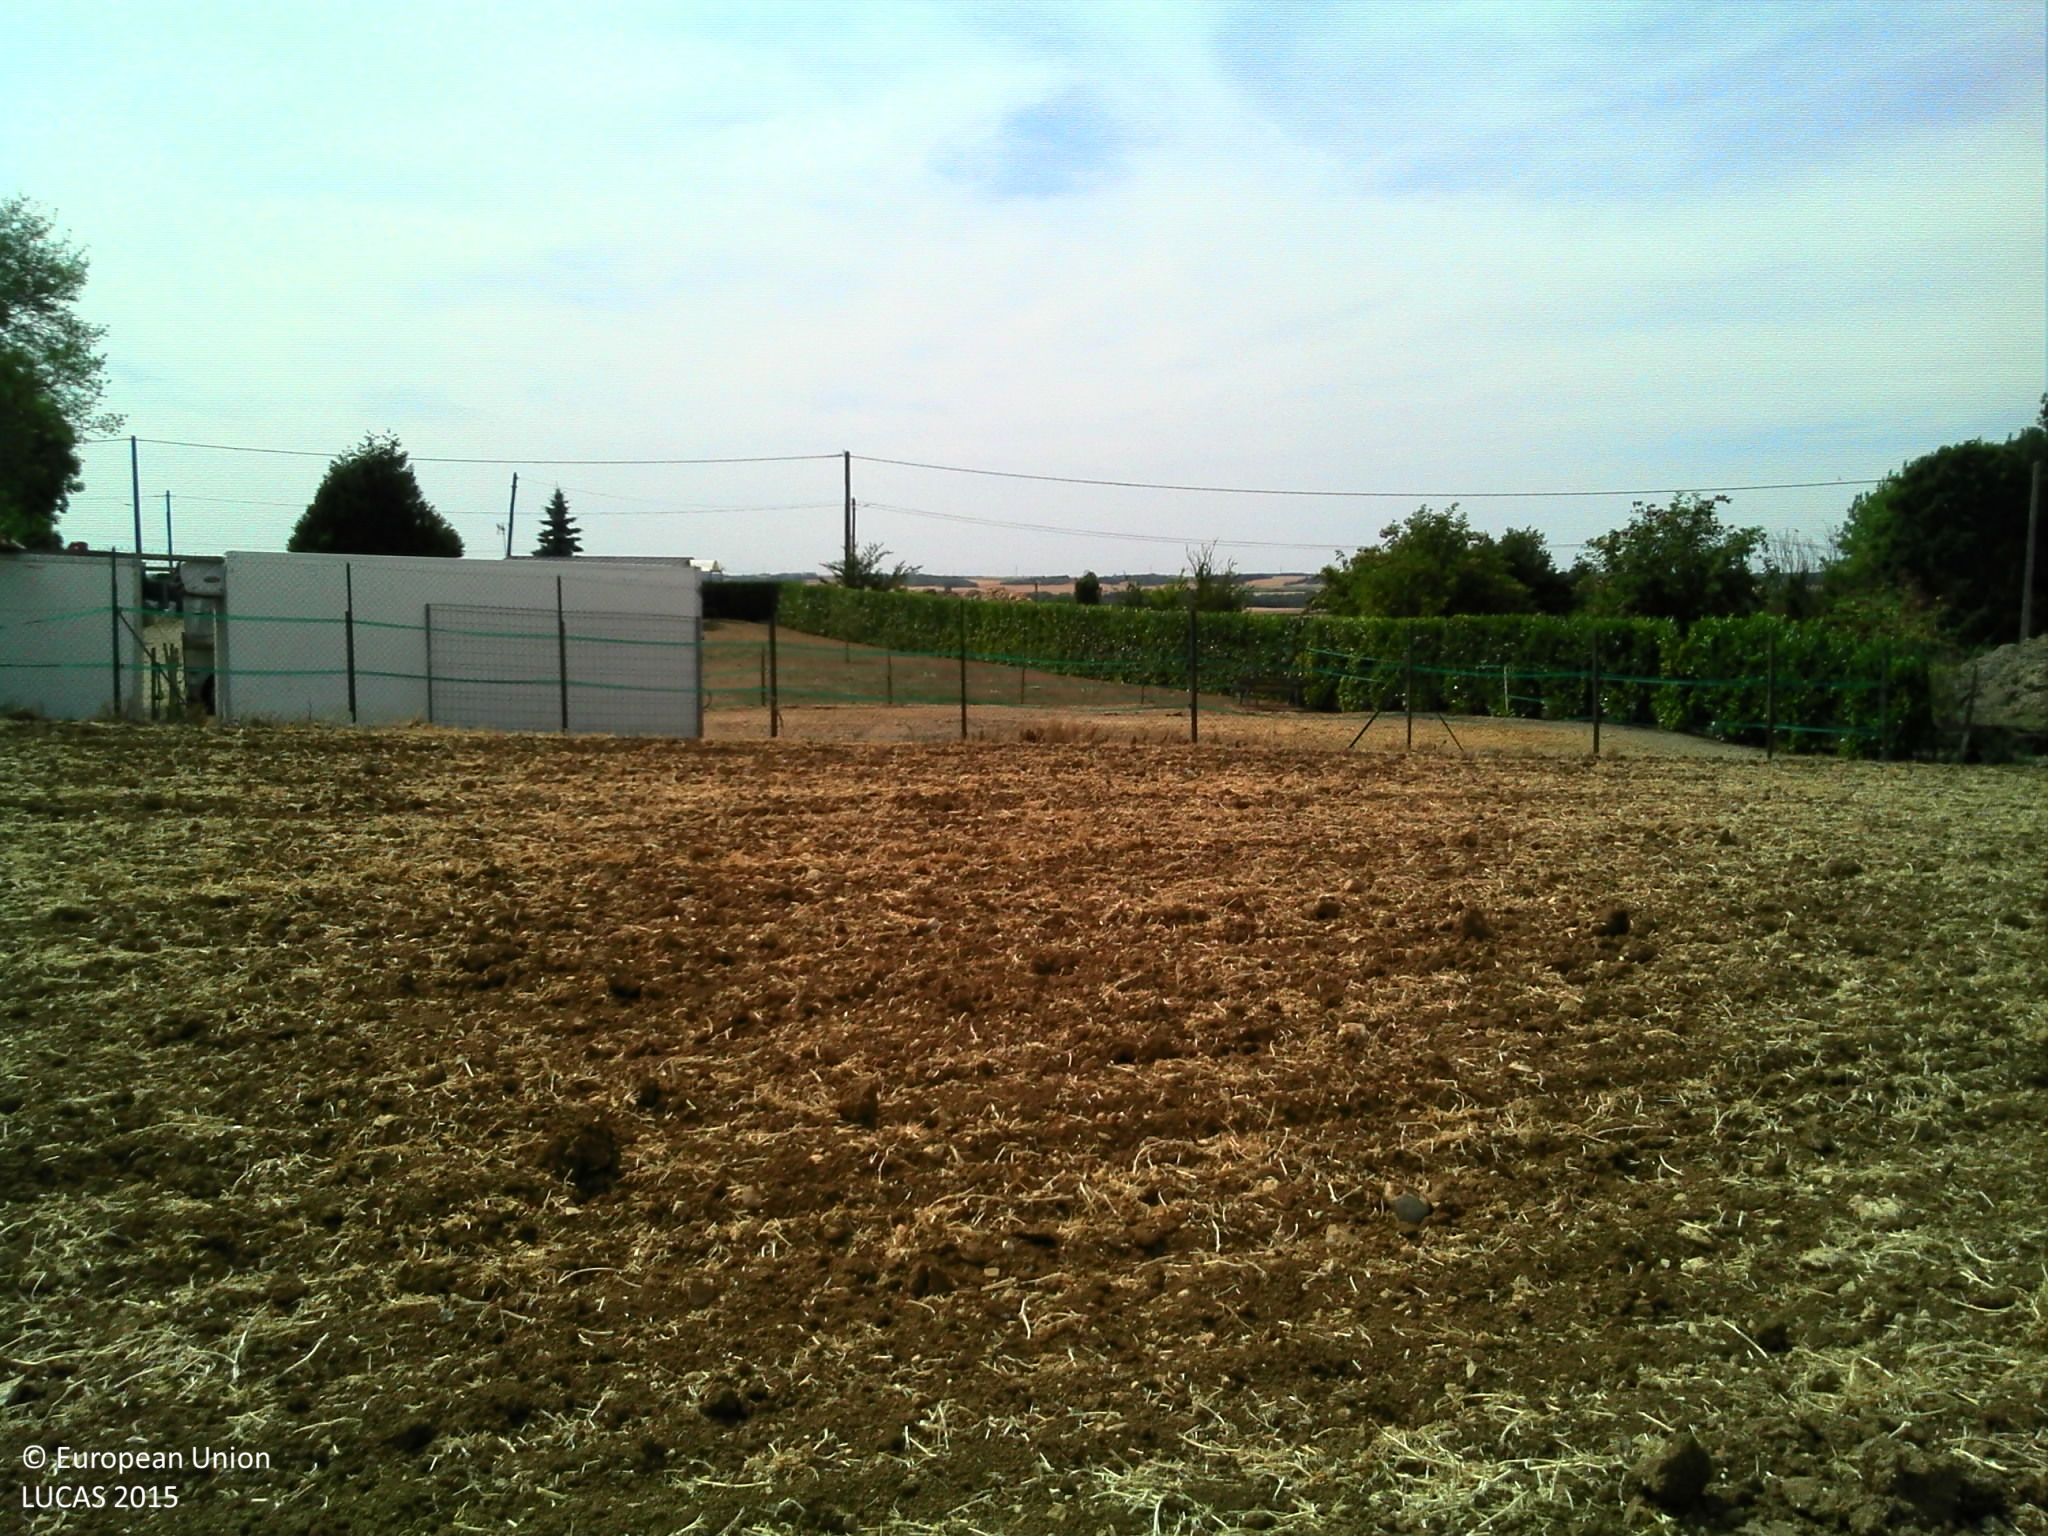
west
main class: Cropland
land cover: Dry pulses
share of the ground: > 75 %
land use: Agriculture (excluding fallow land and kitchen gardens)
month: August
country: FR
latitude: 48.2186
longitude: 2.4660
